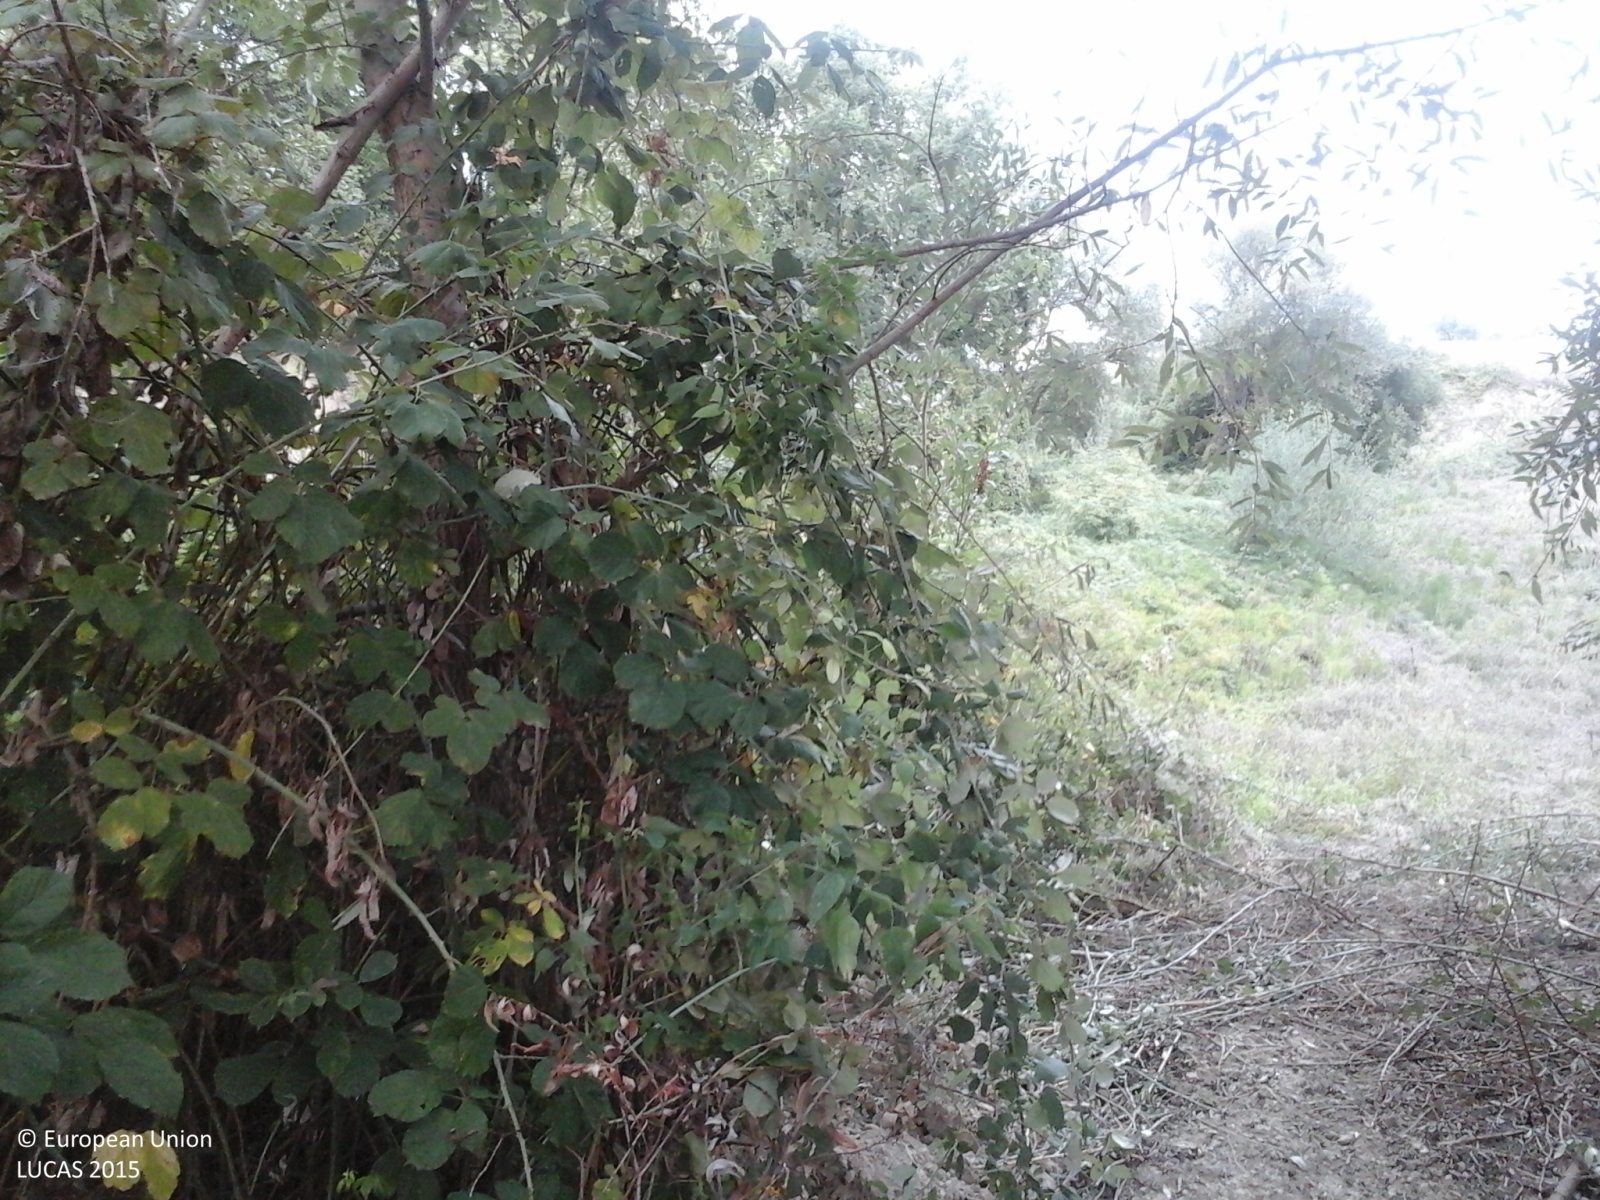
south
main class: Woodland
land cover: Broadleaved woodland
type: thermophilous deciduous forest
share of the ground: > 75 %
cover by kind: broadleaved forest trees 80 %, shrubs 15 %, herbaceous plants 5 %
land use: Semi-natural and natural areas not in use
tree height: > 5 m
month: September
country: IT
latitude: 42.5664
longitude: 13.7529
